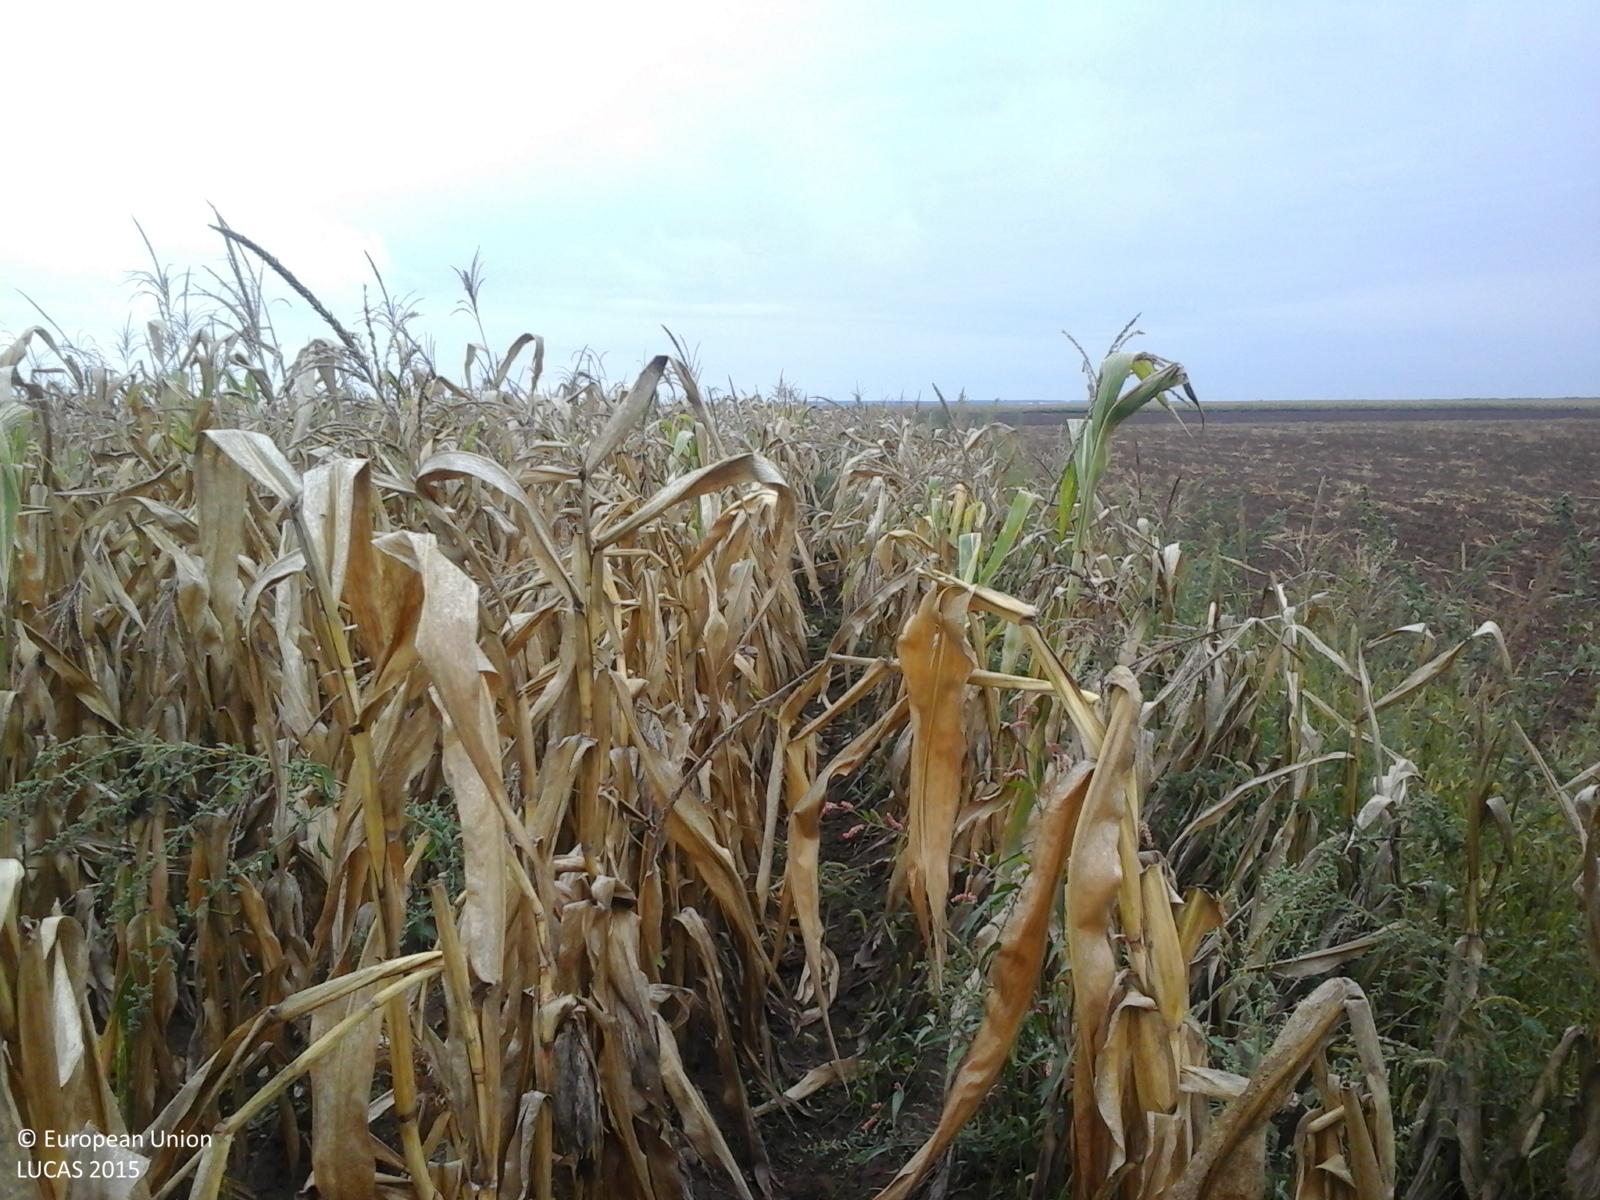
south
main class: Cropland
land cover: Maize
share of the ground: > 75 %
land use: Agriculture (excluding fallow land and kitchen gardens)
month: September
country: RO
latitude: 47.0007
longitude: 21.8416
